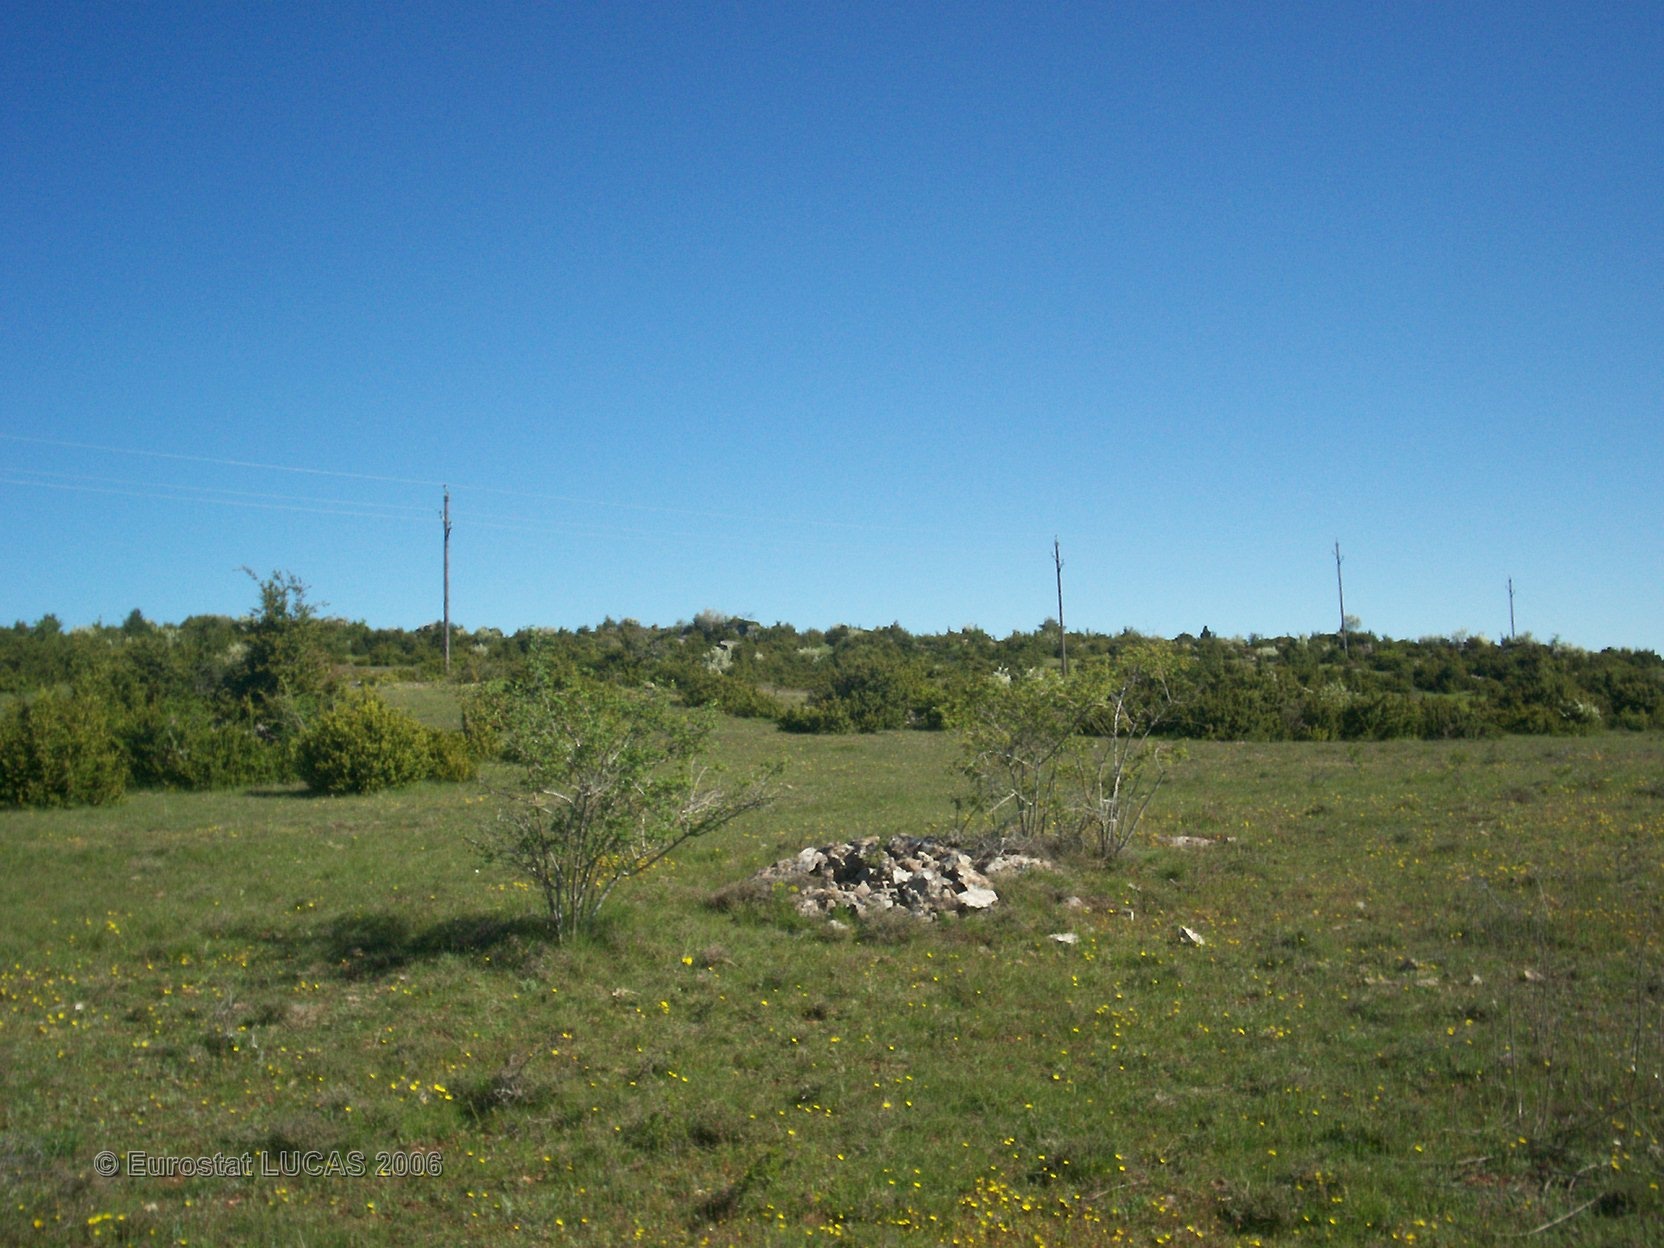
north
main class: Grassland
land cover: Grassland with sparse tree/shrub cover
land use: Agriculture (excluding fallow land and kitchen gardens)
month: May
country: FR
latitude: 43.9588
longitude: 3.3897
